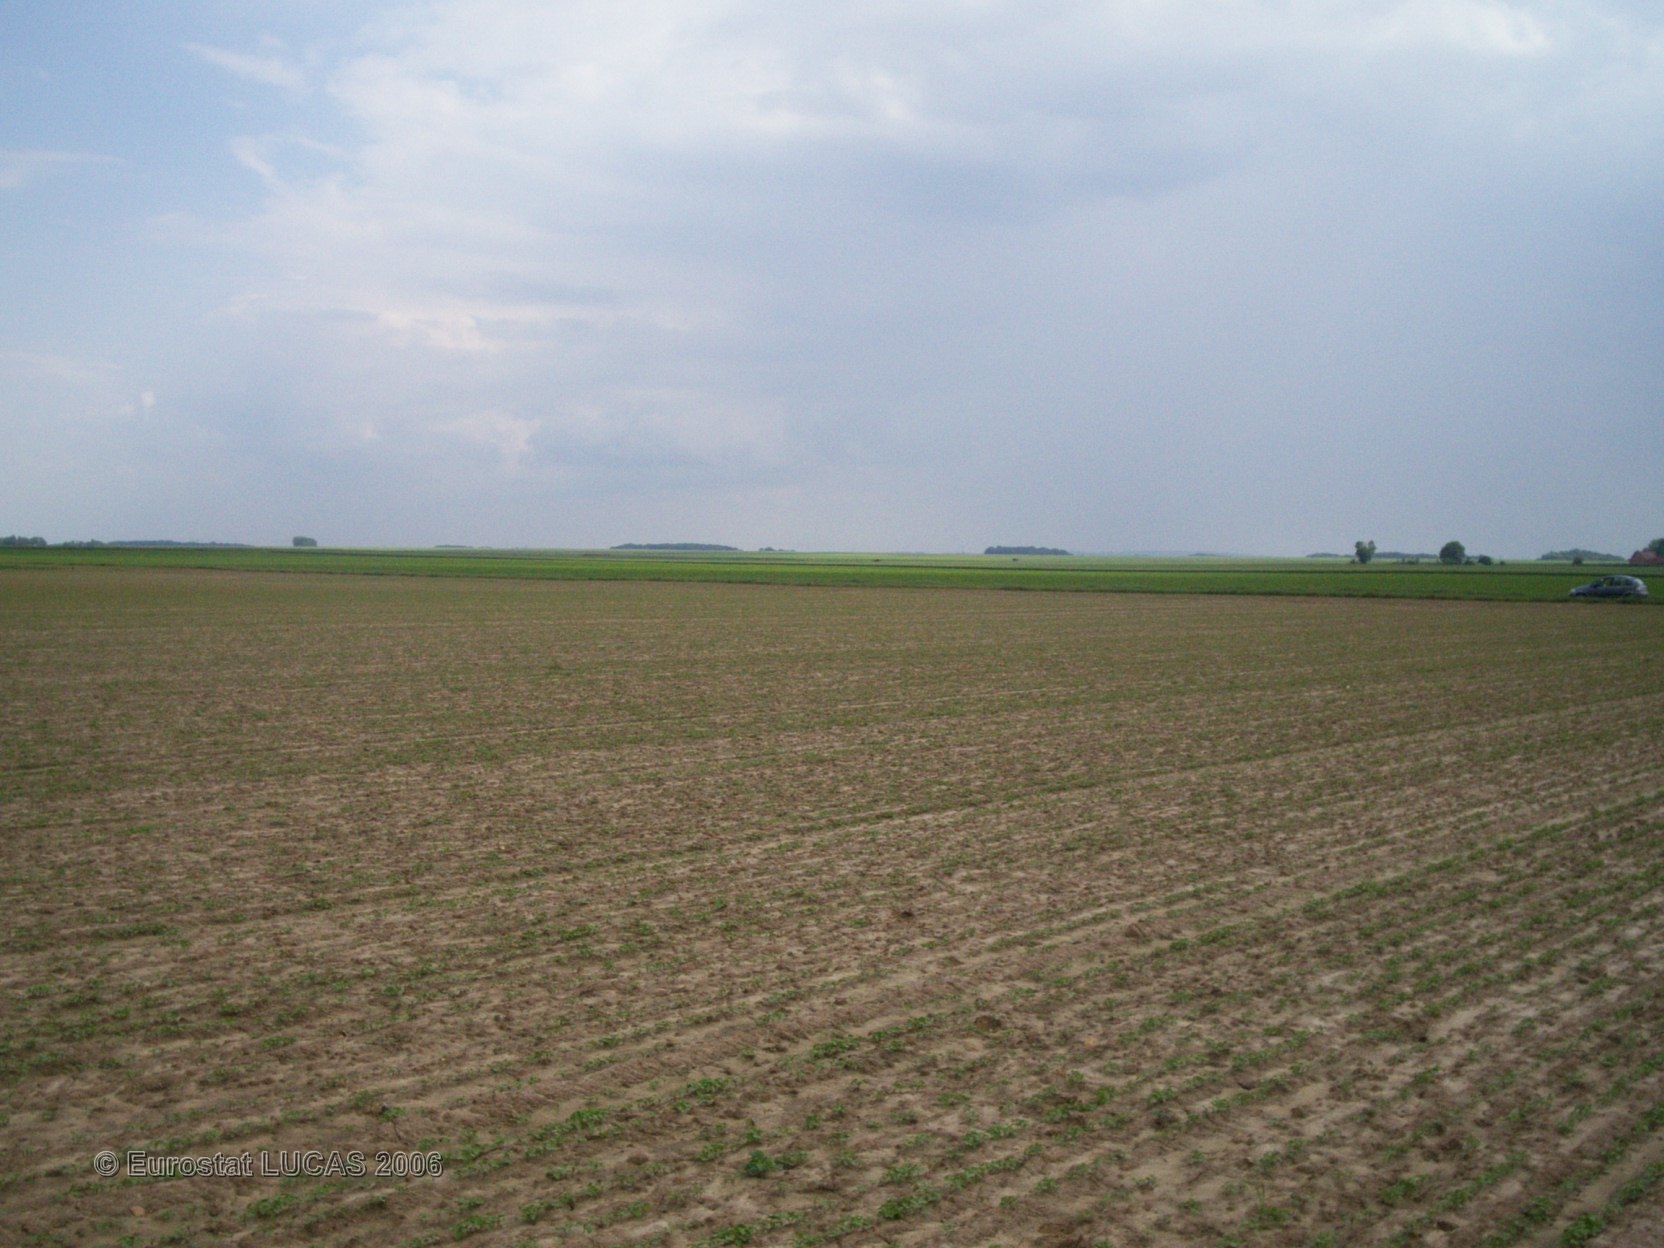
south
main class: Cropland
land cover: Other root crops
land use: Agriculture (excluding fallow land and kitchen gardens)
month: June
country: FR
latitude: 49.7319
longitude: 2.6772
